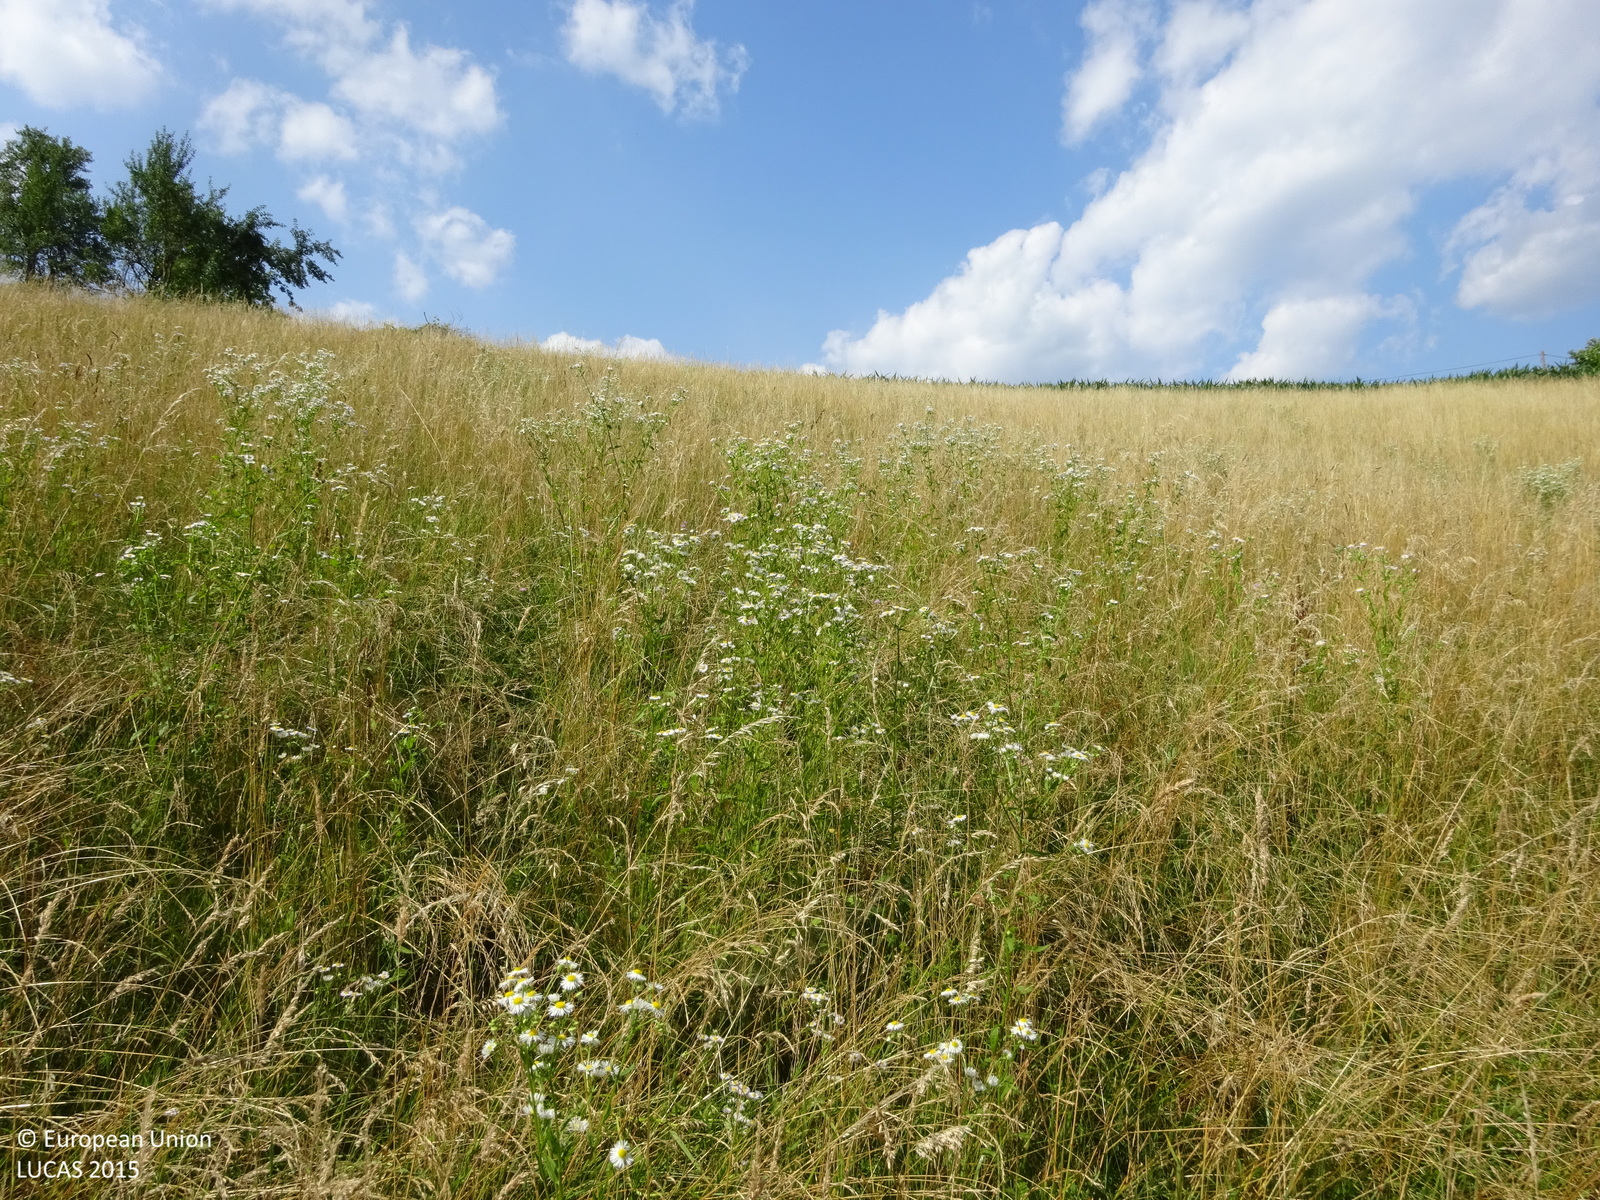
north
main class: Grassland
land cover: Grassland without tree/shrub cover
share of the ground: > 75 %
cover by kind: herbaceous plants 100 %
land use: Agriculture (excluding fallow land and kitchen gardens)
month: July
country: AT
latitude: 46.8856
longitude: 16.0243
